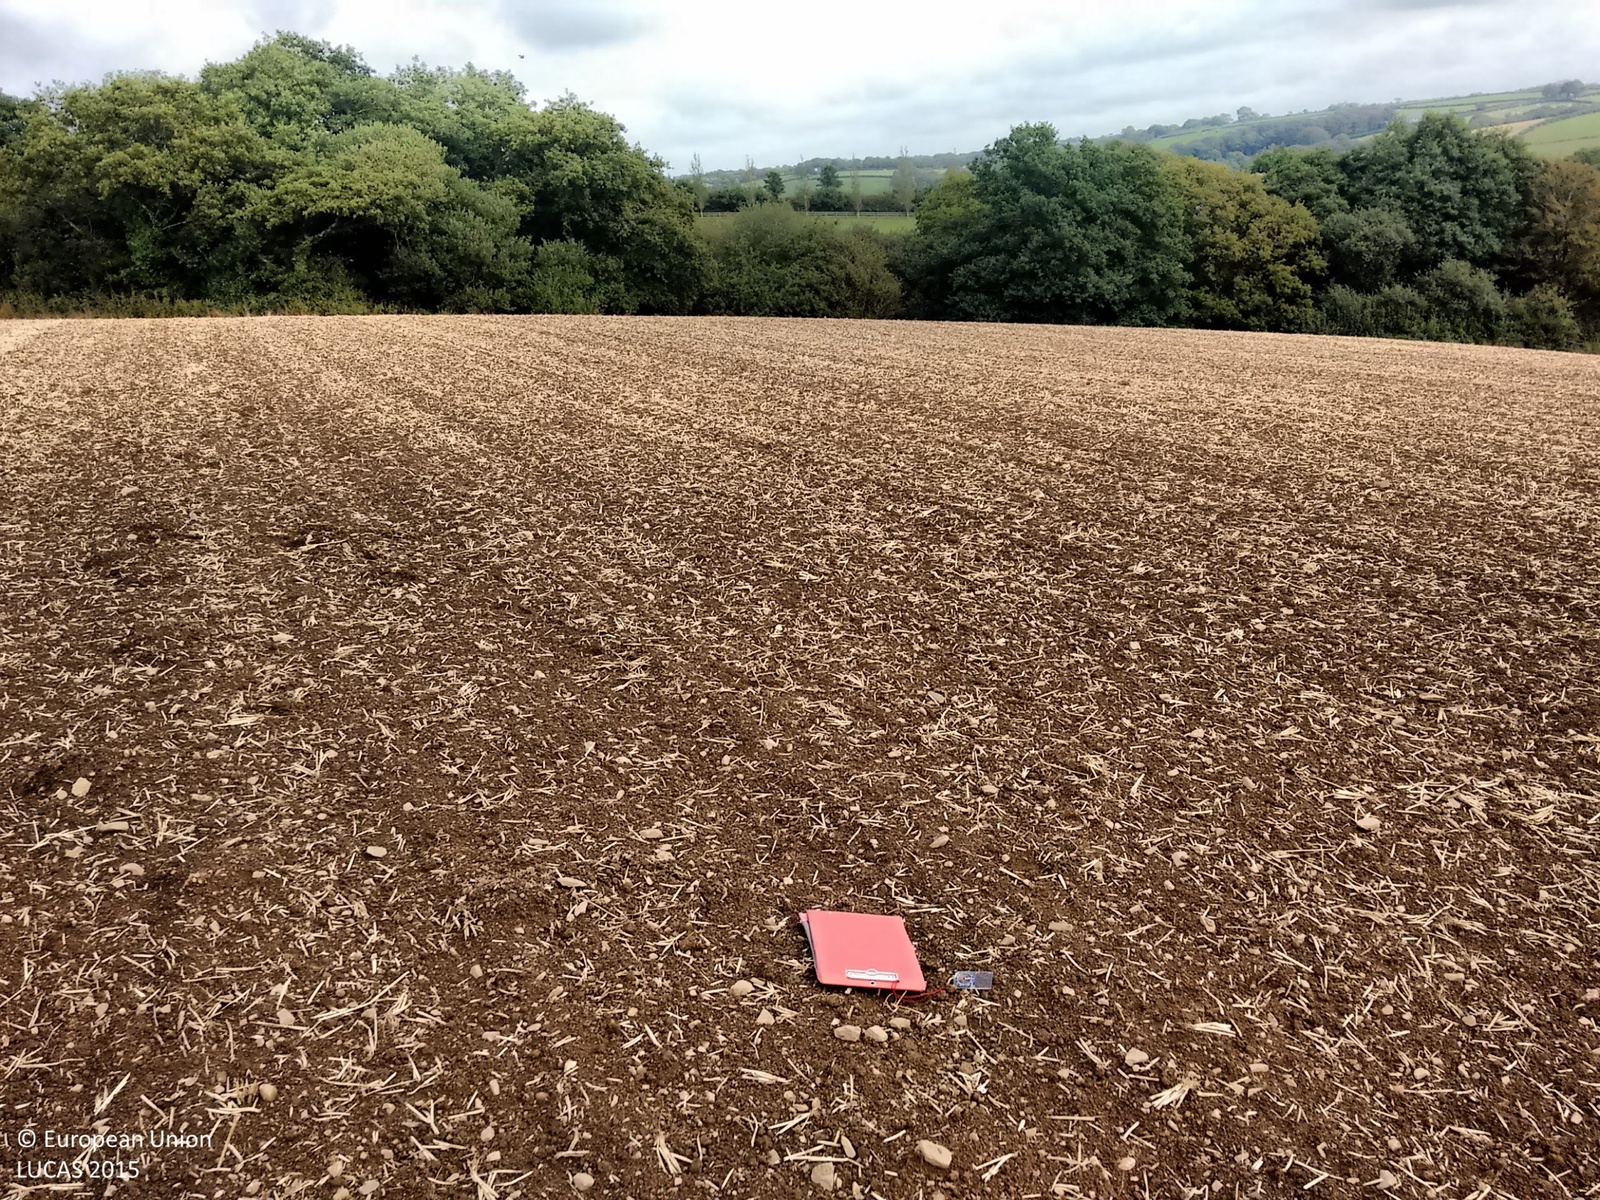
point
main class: Cropland
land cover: Barley
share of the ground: 10 - 25 %
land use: Agriculture (excluding fallow land and kitchen gardens)
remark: Harvested field
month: September
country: GB
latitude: 50.7683
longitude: -4.3514
